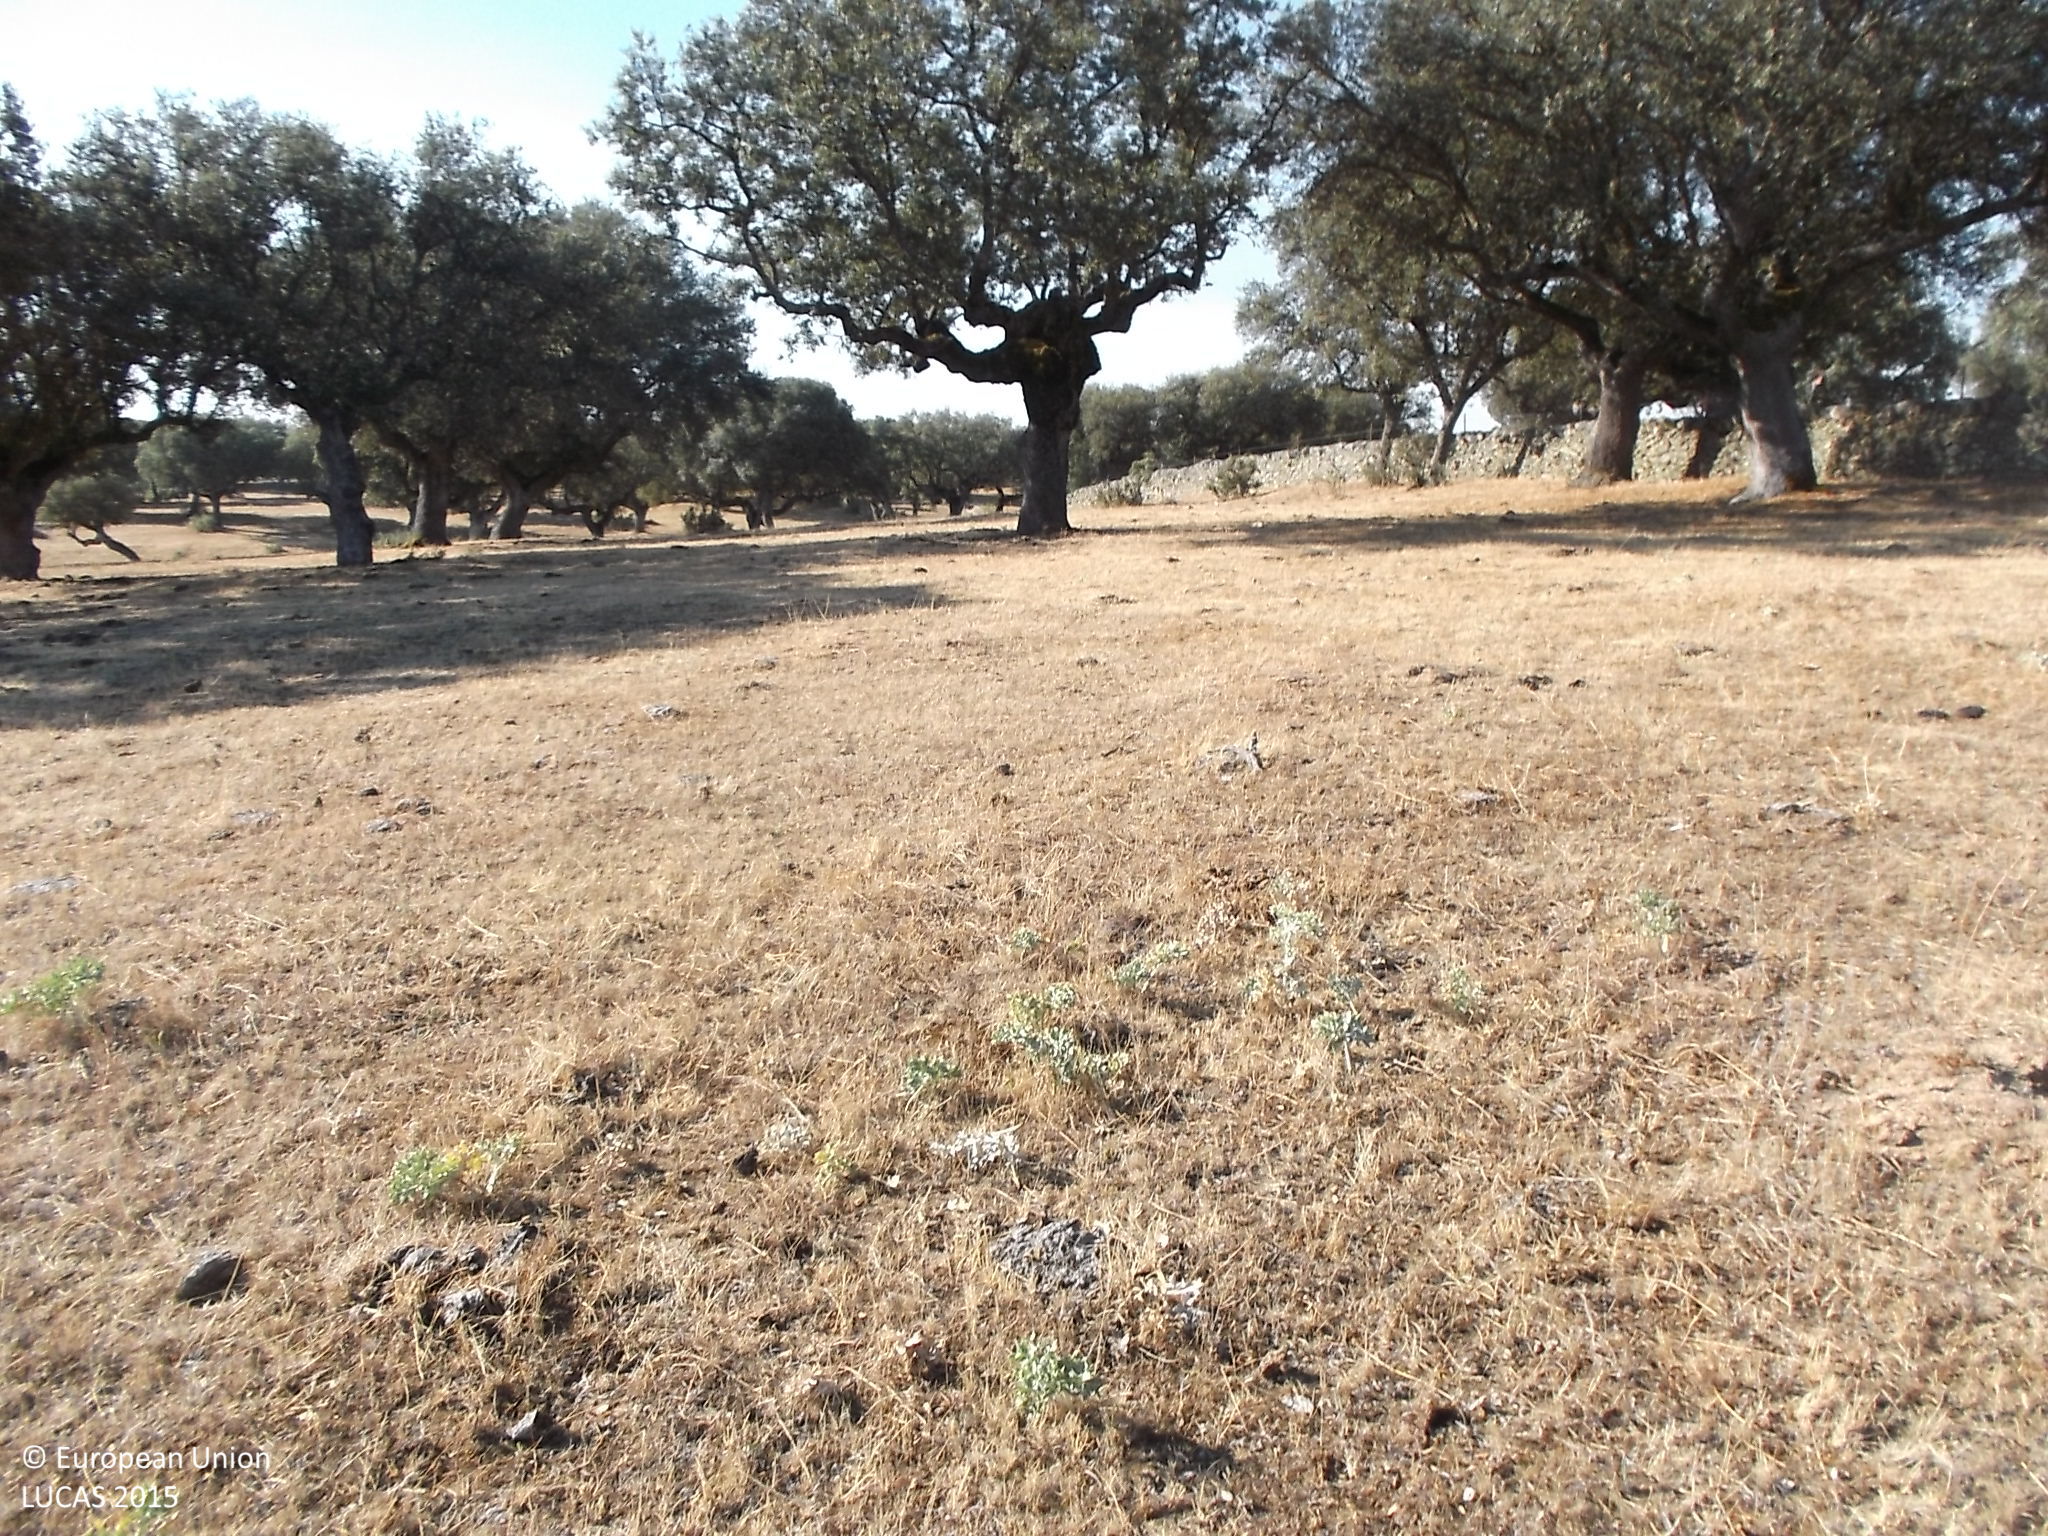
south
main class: Grassland
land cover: Grassland with sparse tree/shrub cover
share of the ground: > 75 %
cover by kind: herbaceous plants 90 %, broadleaved forest trees 5 %, shrubs 5 %
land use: Agriculture (excluding fallow land and kitchen gardens)
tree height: < 5 m
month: July
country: ES
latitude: 41.1037
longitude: -5.9574
